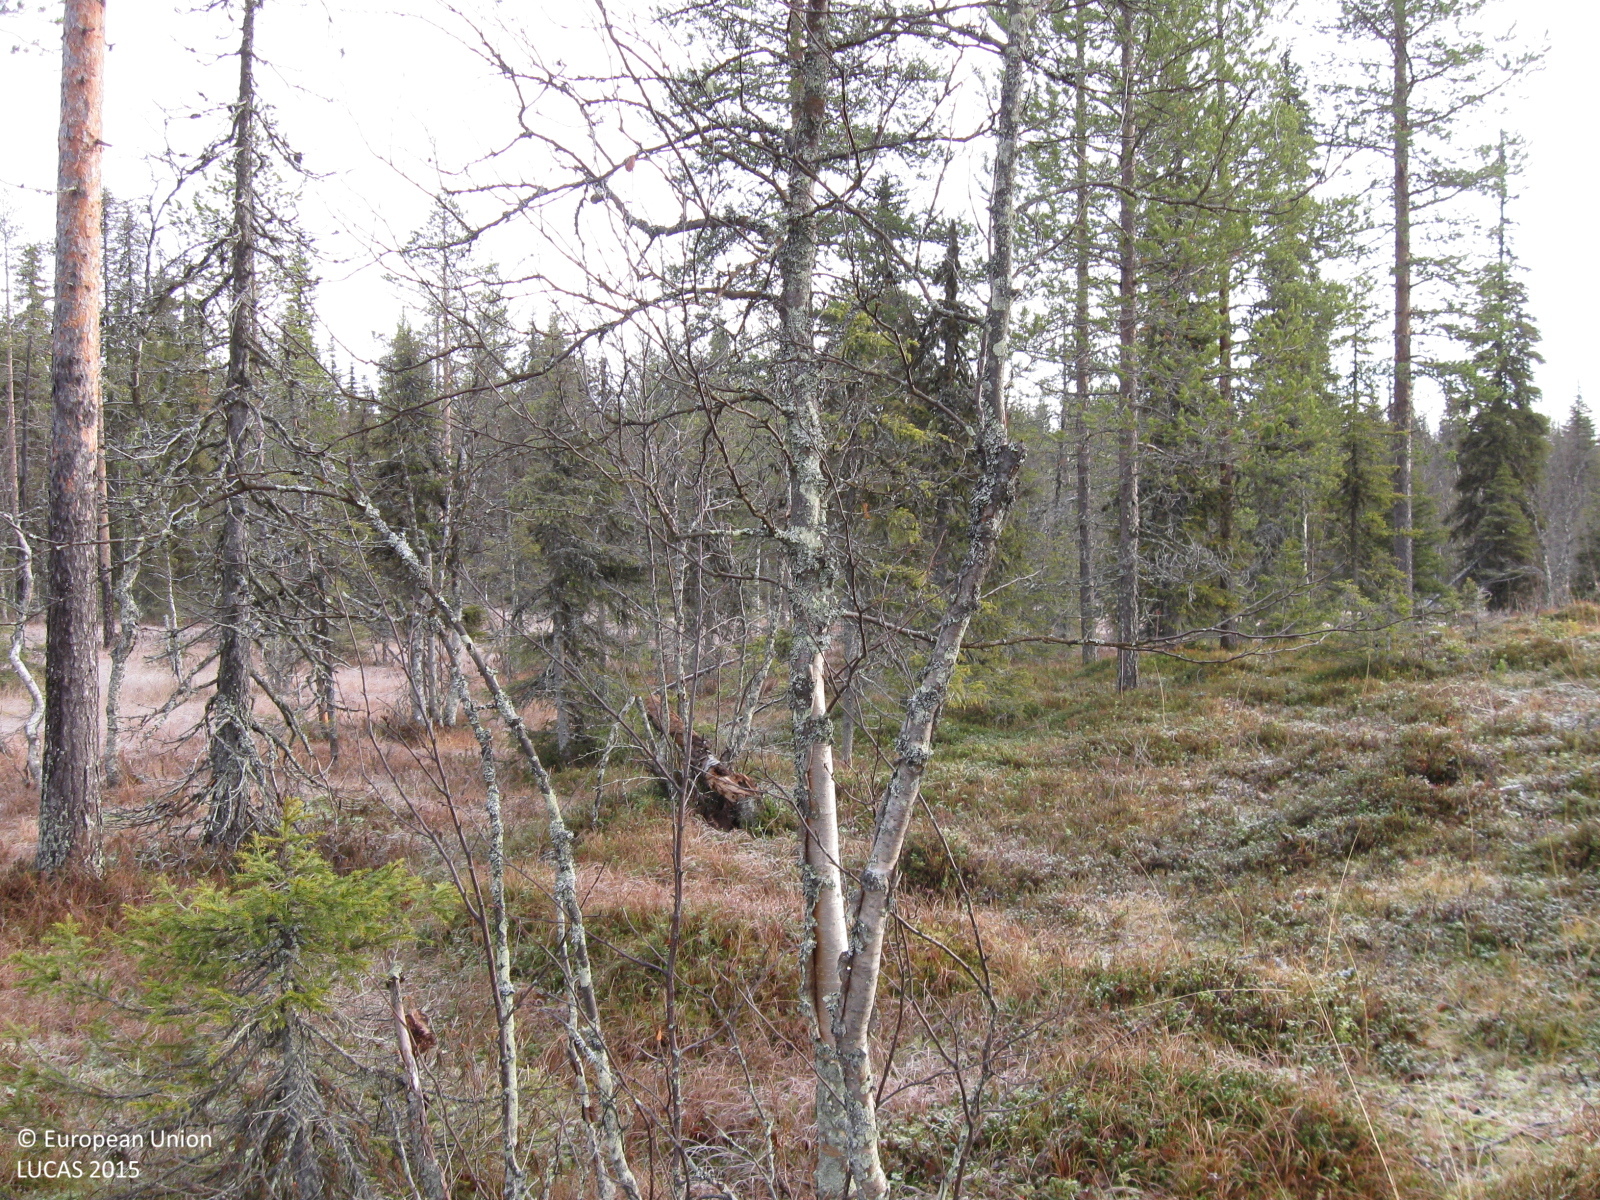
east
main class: Woodland
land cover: Pine dominated coniferous woodland
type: mire and swamp forests
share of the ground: 25 - 50 %
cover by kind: coniferous forest trees 35 %, herbaceous plants 30 %, shrubs 15 %, broadleaved forest trees 10 %, lichens and mosses 10 %
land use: Forestry
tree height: > 5 m
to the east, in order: Pine dominated coniferous woodland; Other mixed woodland; Spruce dominated mixed woodland; Rivers and streams; Spruce dominated mixed woodland; Pine dominated coniferous woodland; Peatbogs; Spruce dominated coniferous woodland
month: October
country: SE
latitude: 66.5031
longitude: 21.5383
